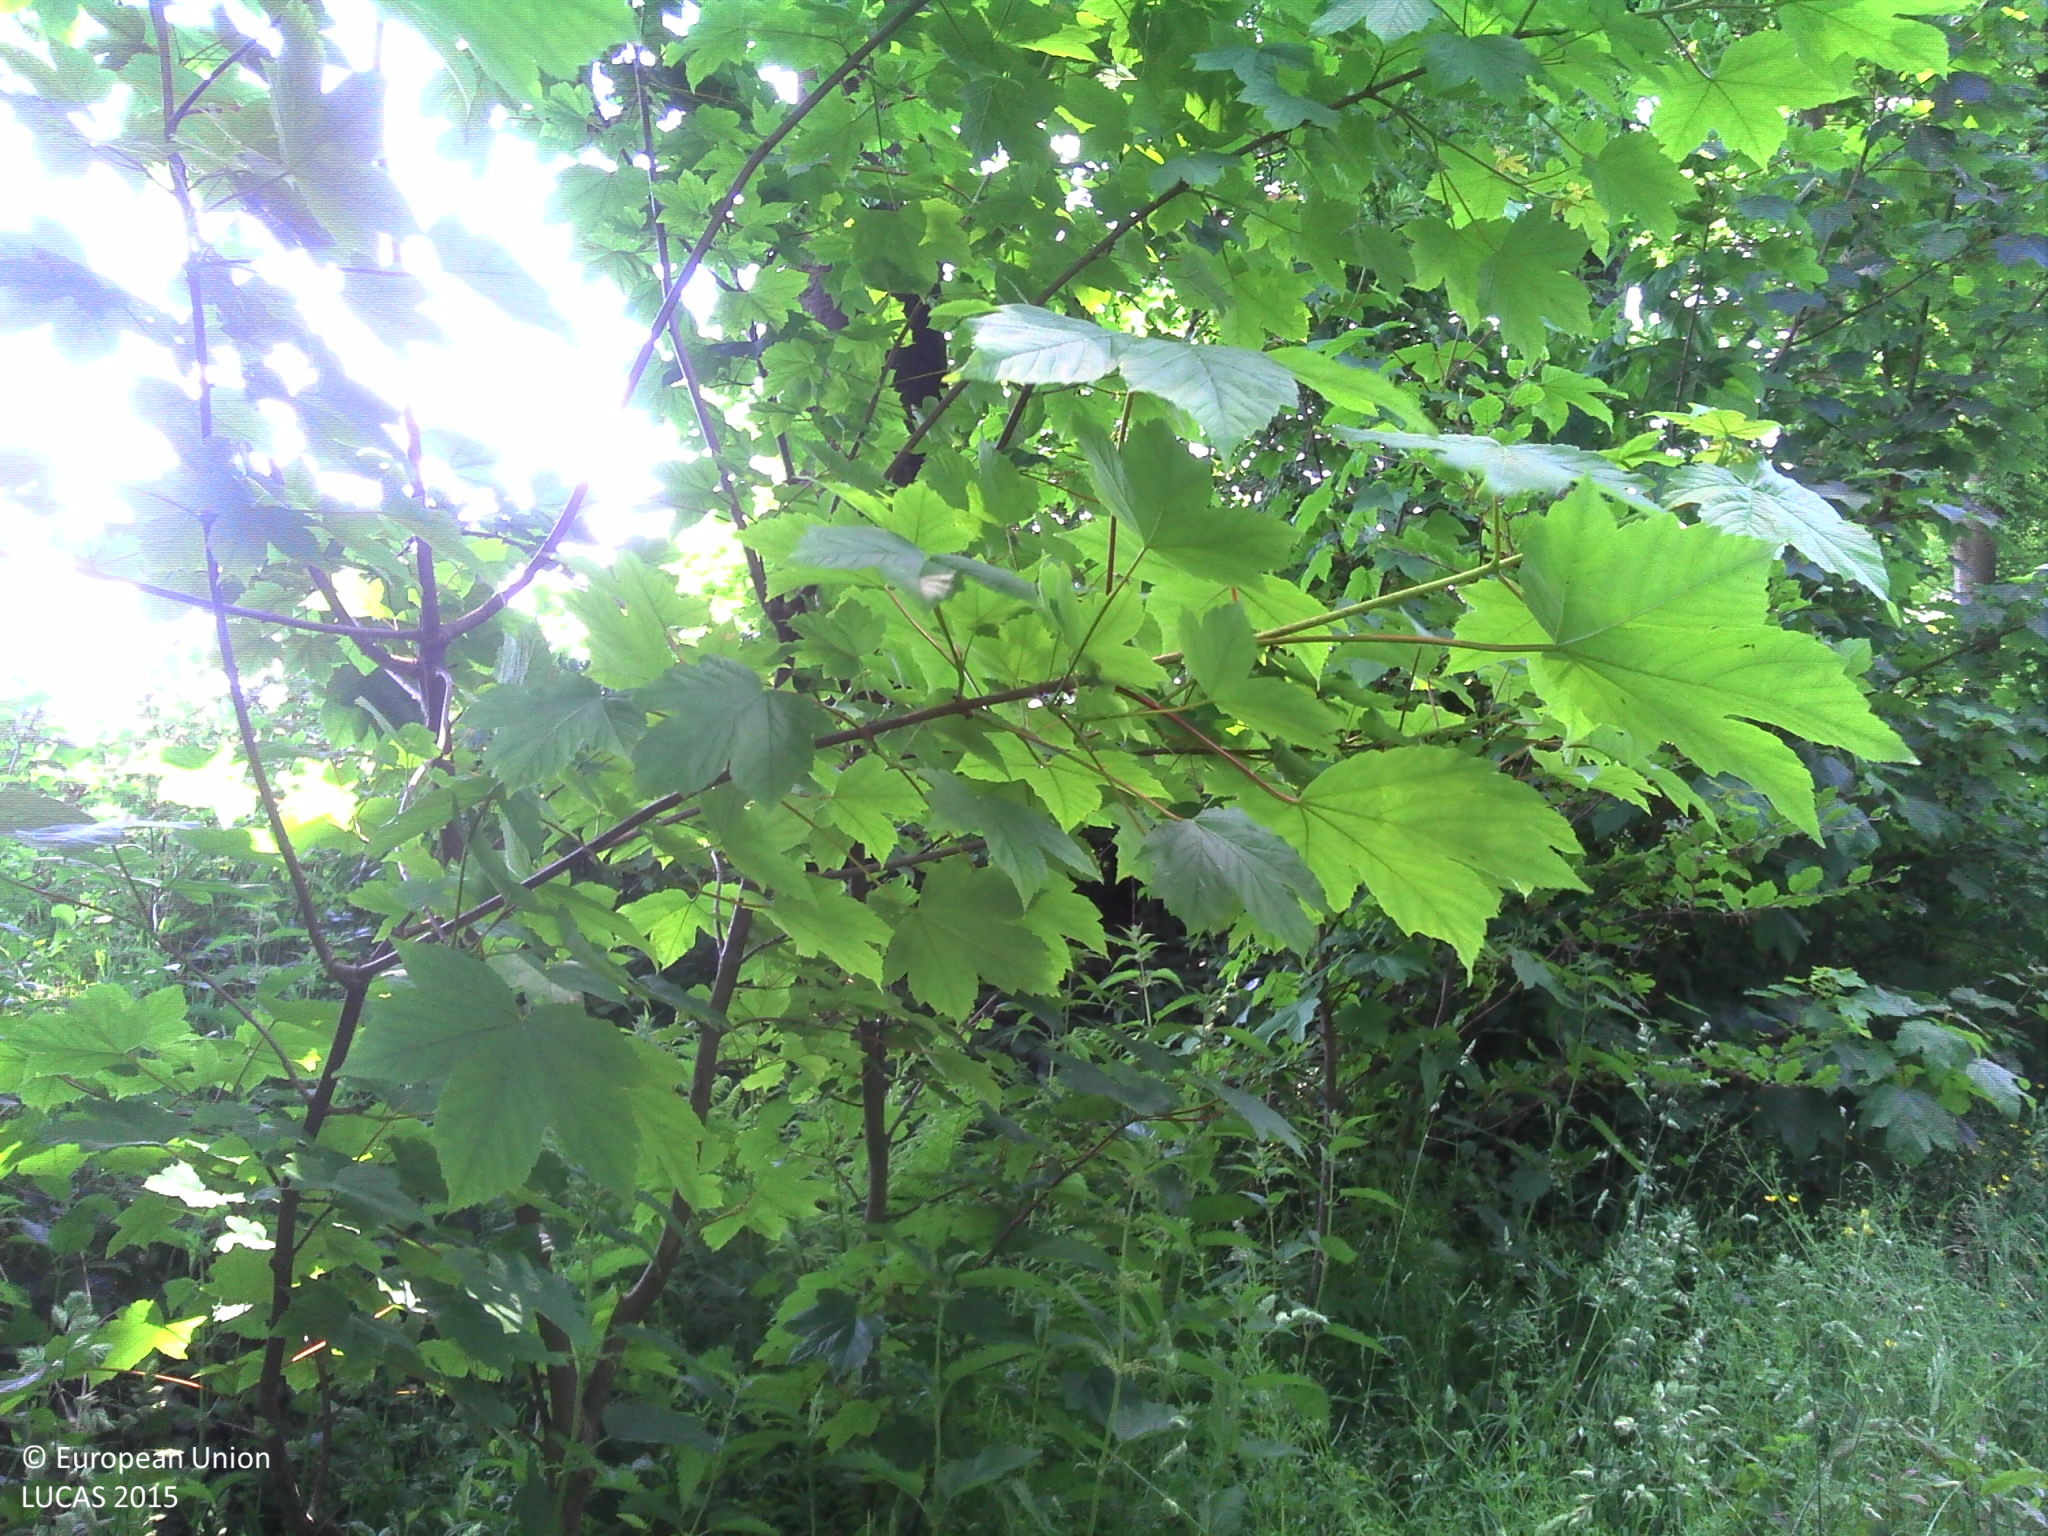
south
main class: Woodland
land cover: Broadleaved woodland
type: acidophilous oak and oak-birch forest
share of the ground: > 75 %
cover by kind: broadleaved forest trees 95 %, herbaceous plants 5 %
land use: Forestry
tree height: > 5 m
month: June
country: BE
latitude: 49.9788
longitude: 4.4877
